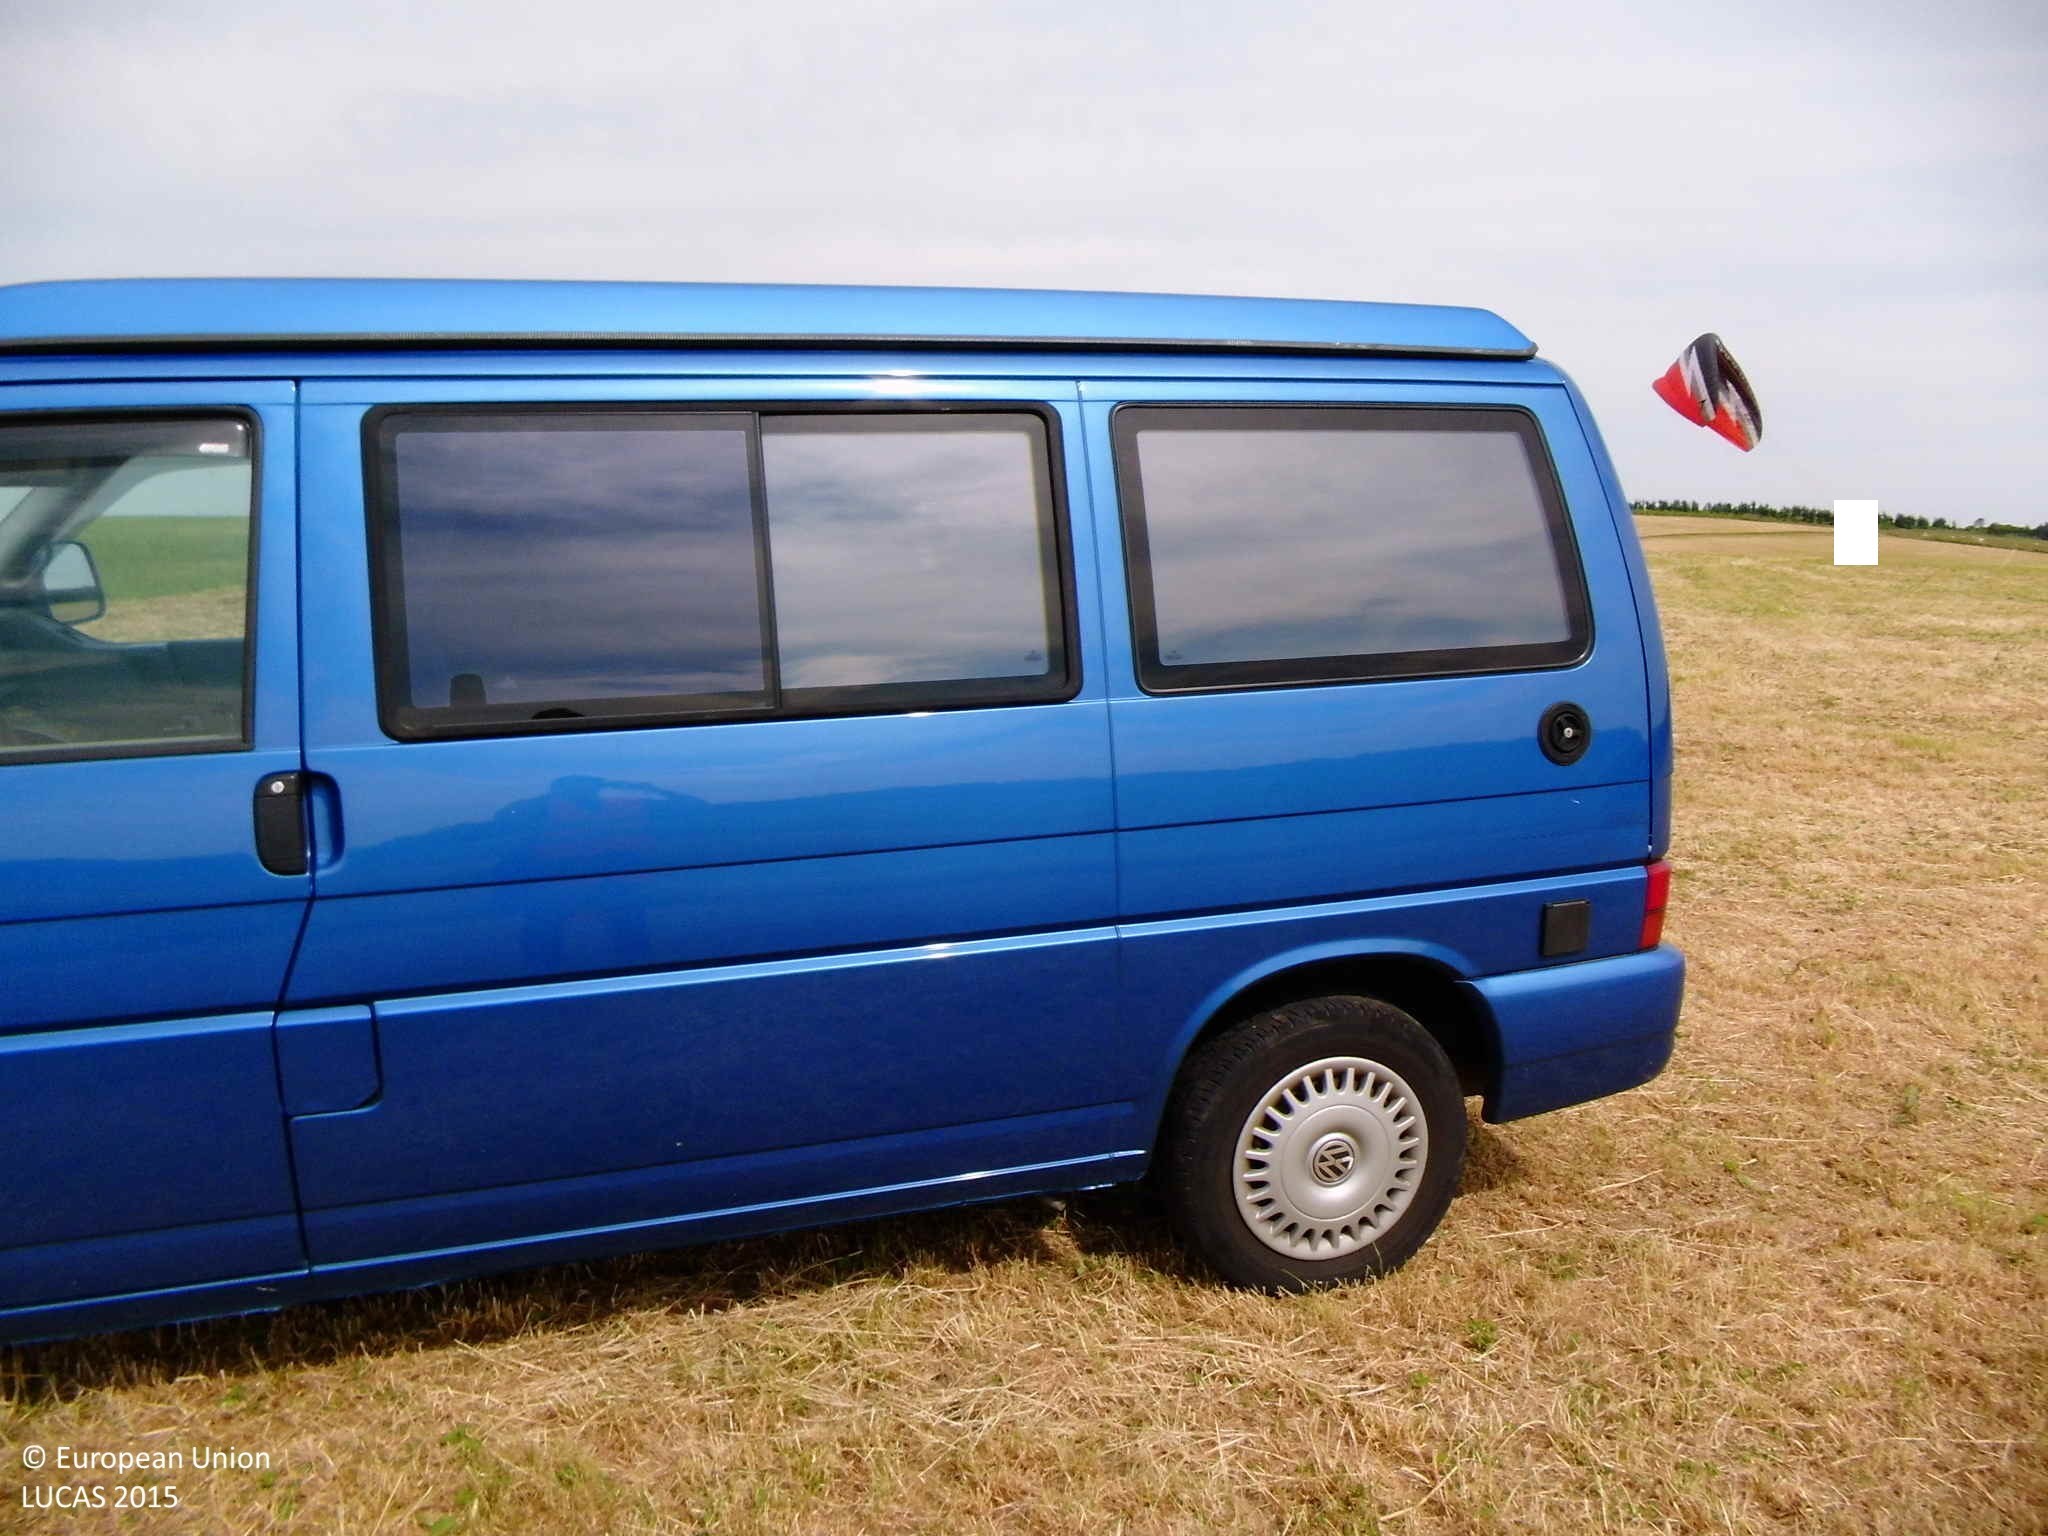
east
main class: Grassland
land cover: Grassland without tree/shrub cover
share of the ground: > 75 %
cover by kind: herbaceous plants 100 %
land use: Agriculture (excluding fallow land and kitchen gardens)
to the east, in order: Grassland without tree/shrub cover; Paved roads, cycling and walking lanes; Grass margins; Fences; Grassland without tree/shrub cover
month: June
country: DE
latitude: 51.1809
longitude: 7.4395
